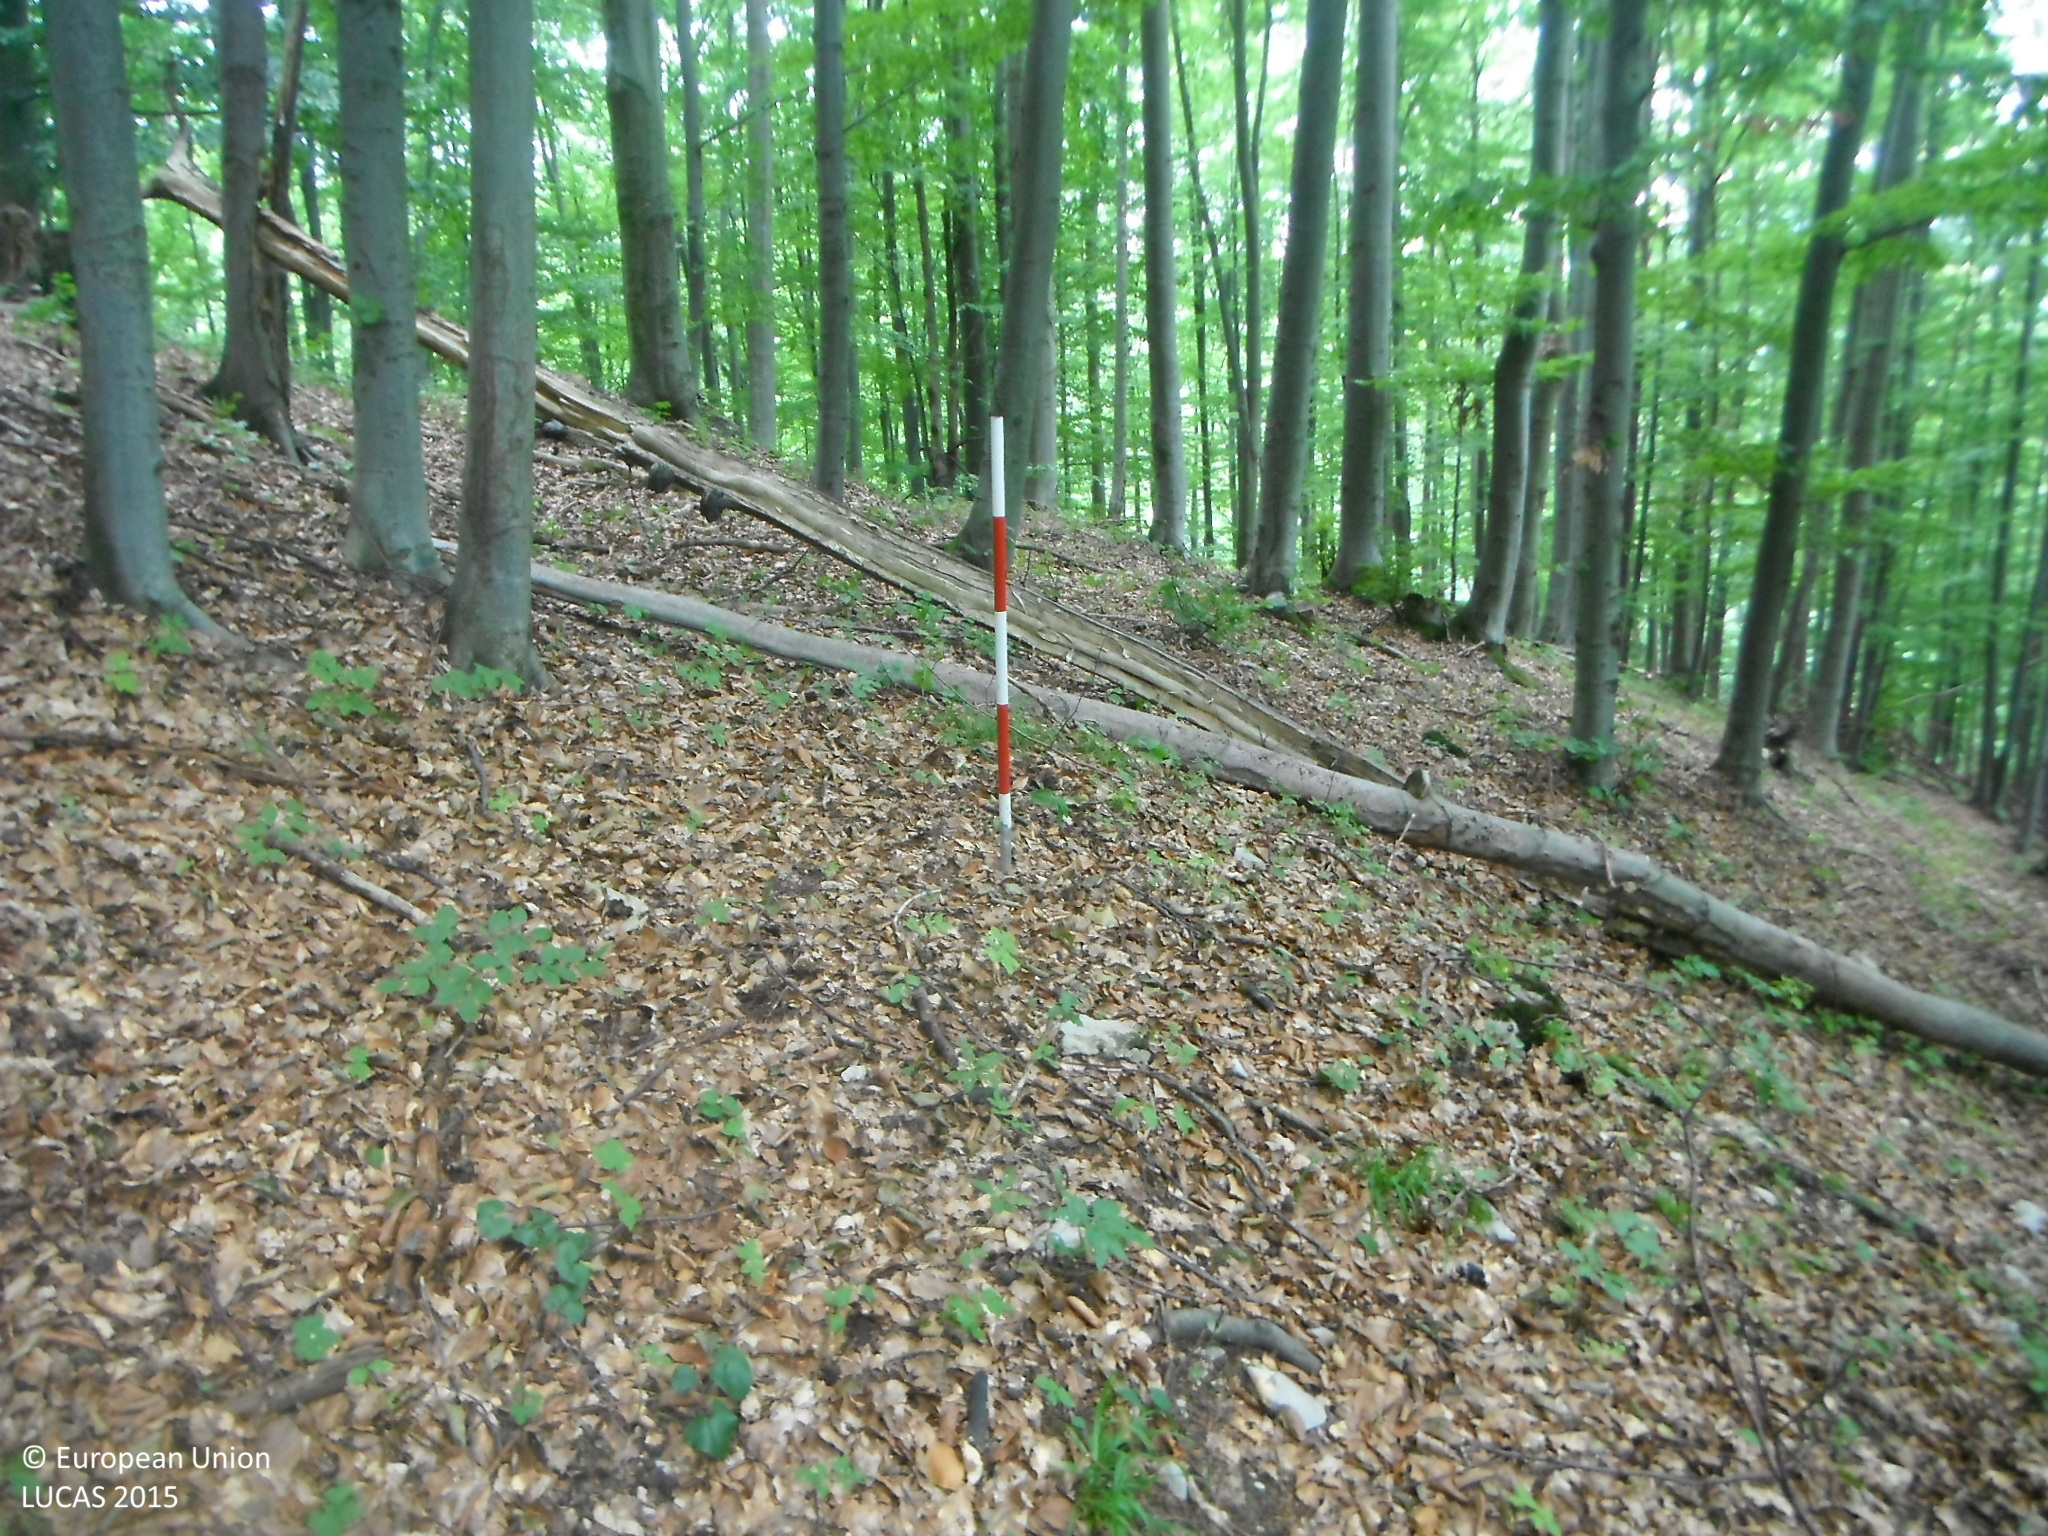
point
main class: Woodland
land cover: Broadleaved woodland
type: mountainous beech forest
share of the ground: > 75 %
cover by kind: broadleaved forest trees 90 %, herbaceous plants 5 %, consolidated bare surface 5 %
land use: Forestry
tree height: > 5 m
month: September
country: SK
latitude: 48.9148
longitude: 18.4090
